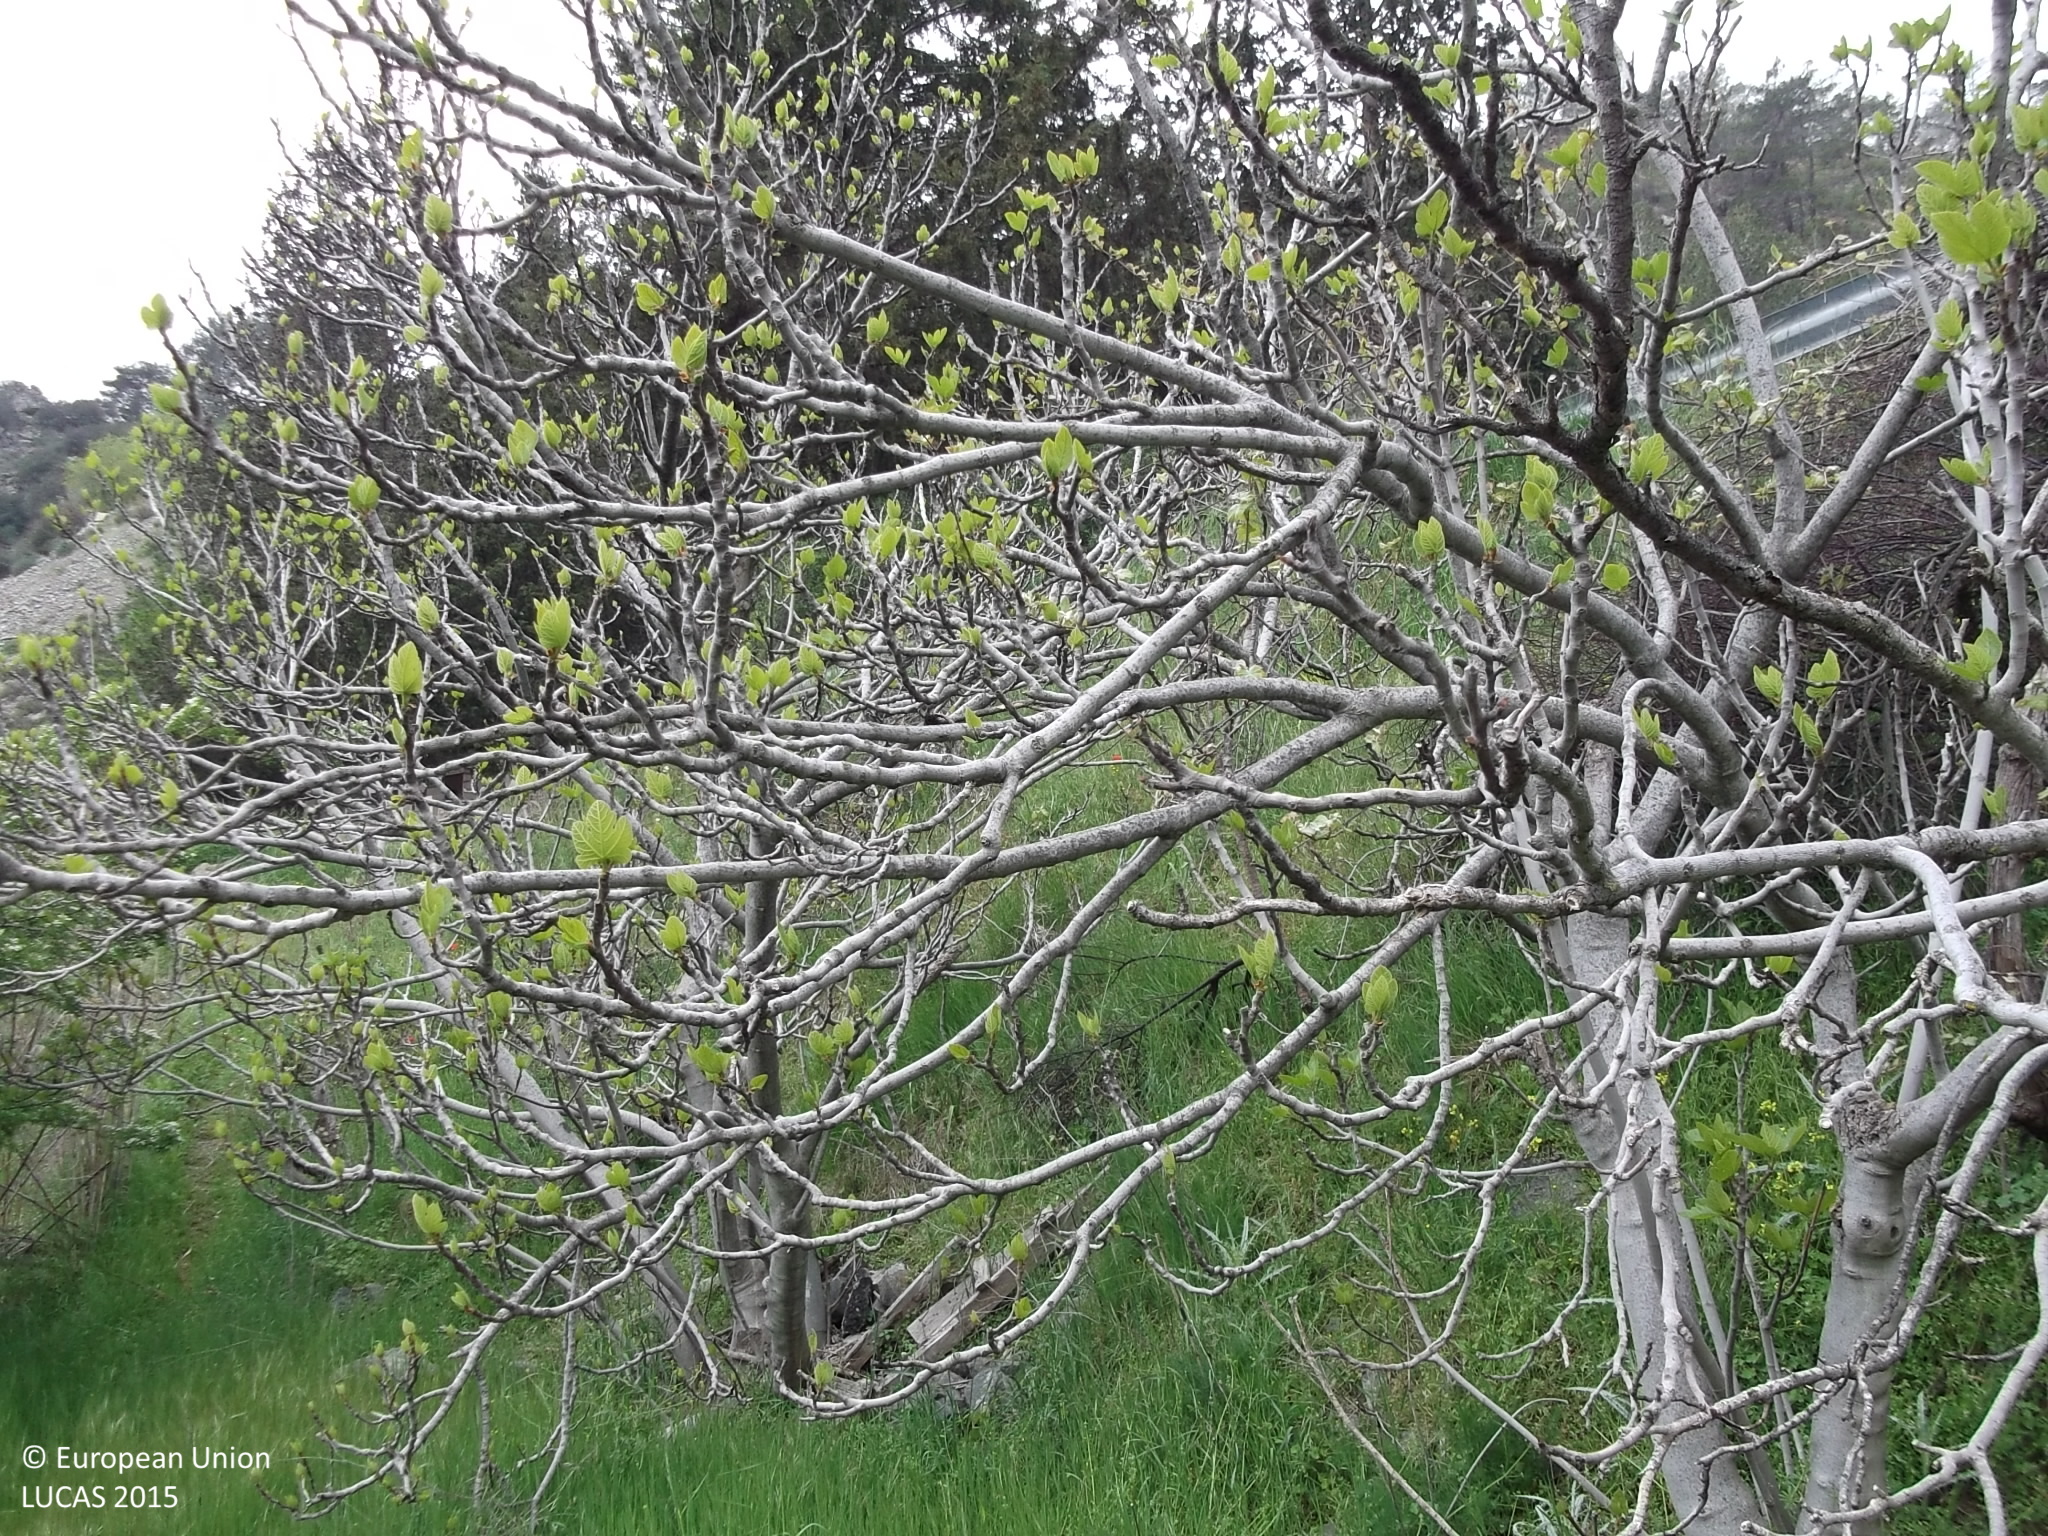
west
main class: Cropland
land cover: Other fruit trees and berries
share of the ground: 10 - 25 %
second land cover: Grassland without tree/shrub cover
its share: > 75 %
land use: Agriculture (excluding fallow land and kitchen gardens)
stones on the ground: 25 - 50 %
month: April
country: CY
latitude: 34.8983
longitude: 33.0321
